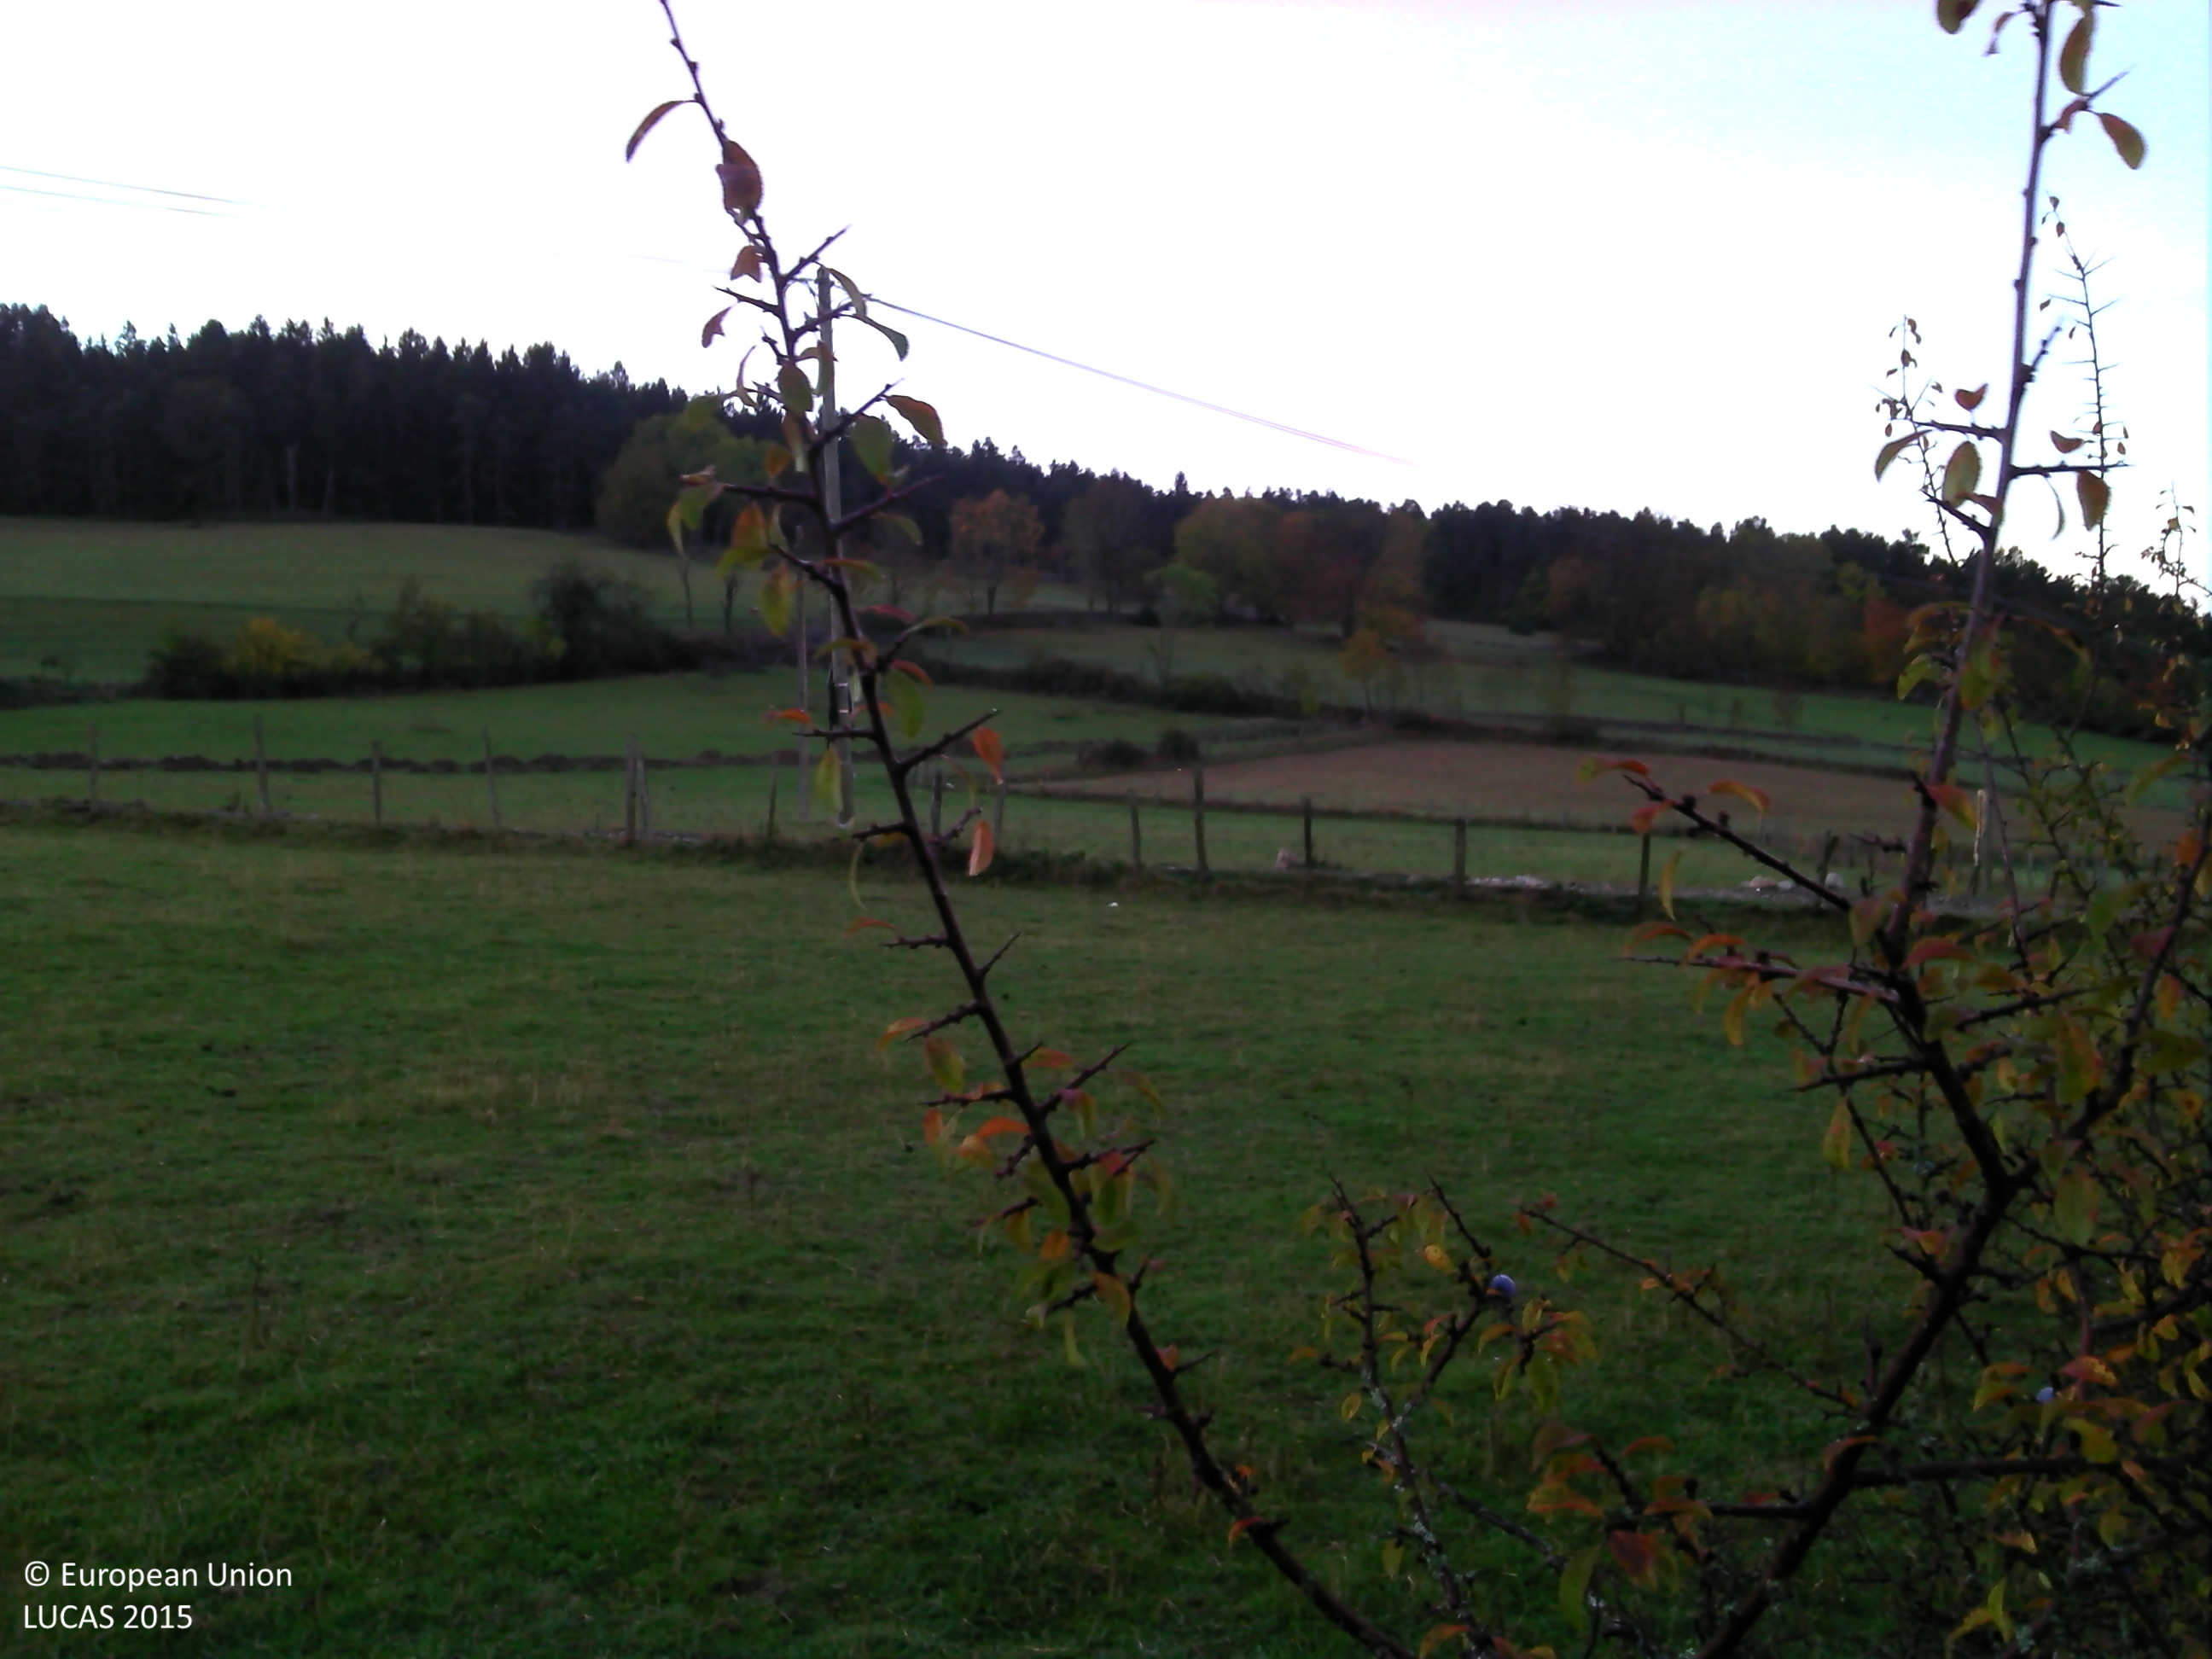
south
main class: Cropland
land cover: Common wheat
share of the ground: 25 - 50 %
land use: Agriculture (excluding fallow land and kitchen gardens)
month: October
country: FR
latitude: 45.0911
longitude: 3.8669
